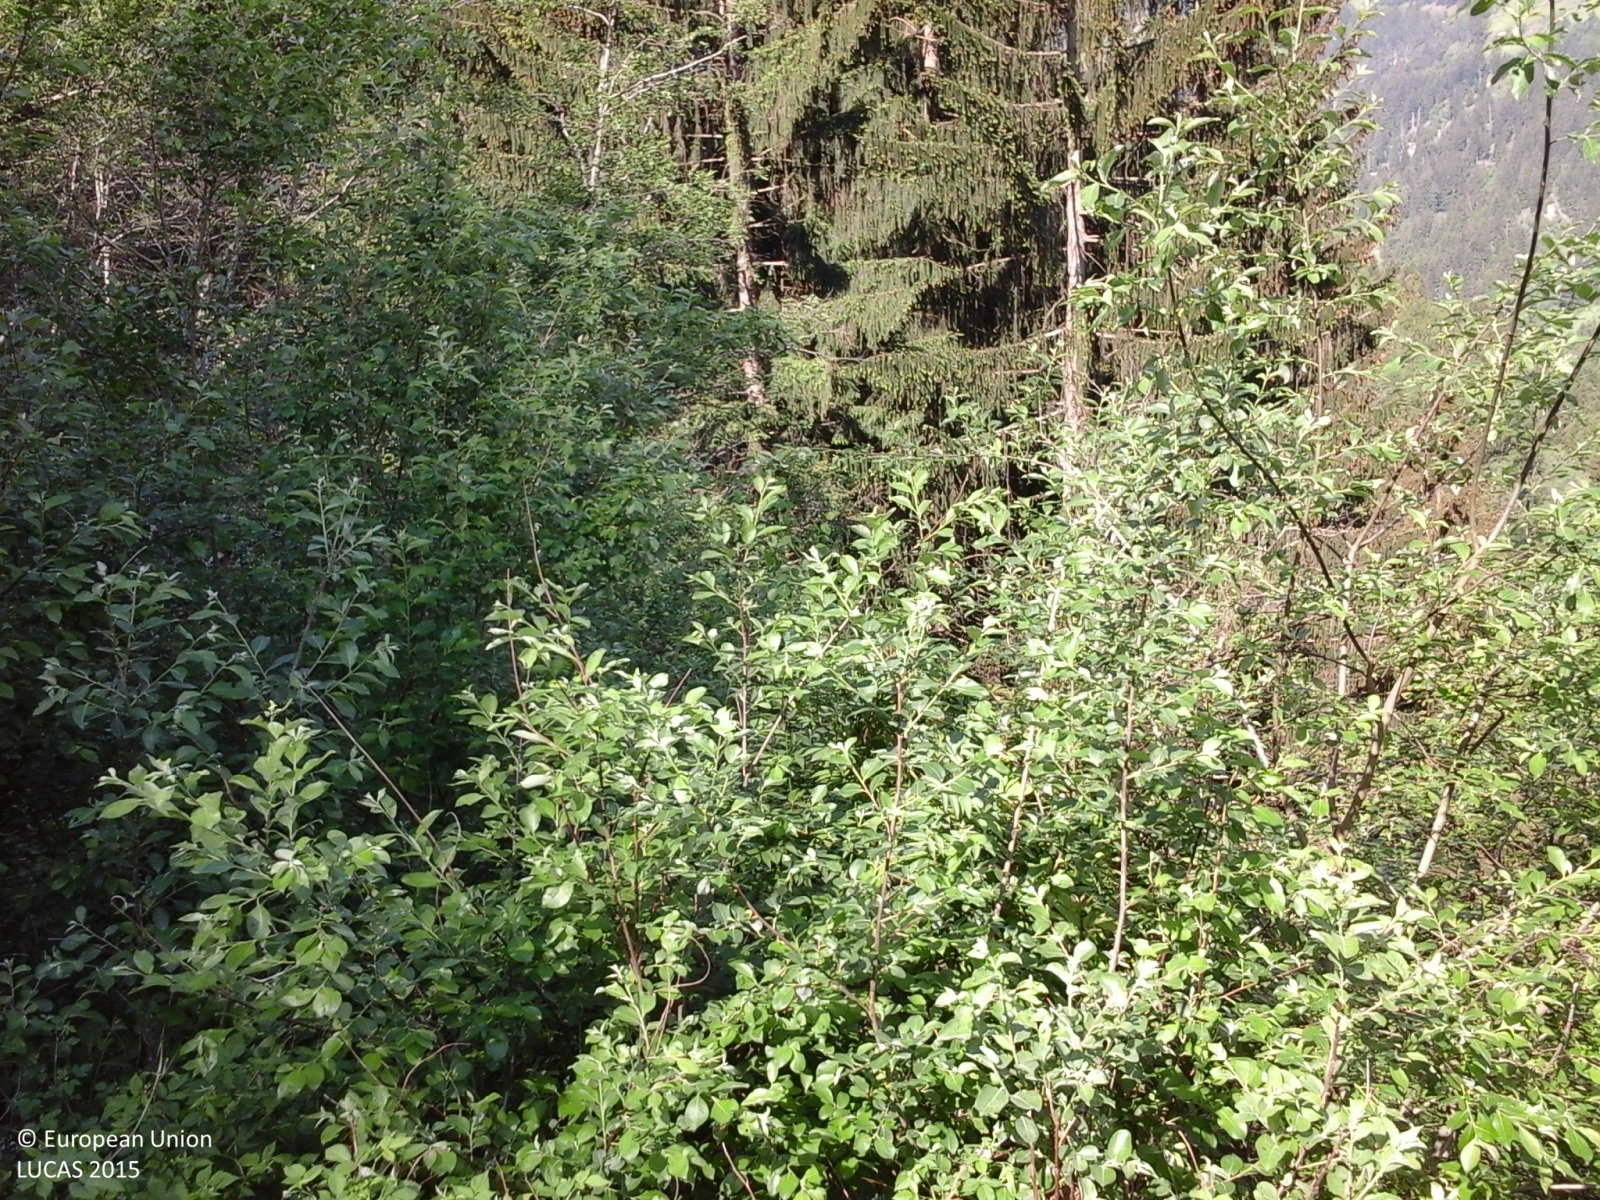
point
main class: Woodland
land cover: Spruce dominated mixed woodland
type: alpine coniferous forest
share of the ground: > 75 %
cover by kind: coniferous forest trees 70 %, broadleaved forest trees 30 %
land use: Forestry
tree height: > 5 m
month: May
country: IT
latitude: 46.5622
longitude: 11.0554
